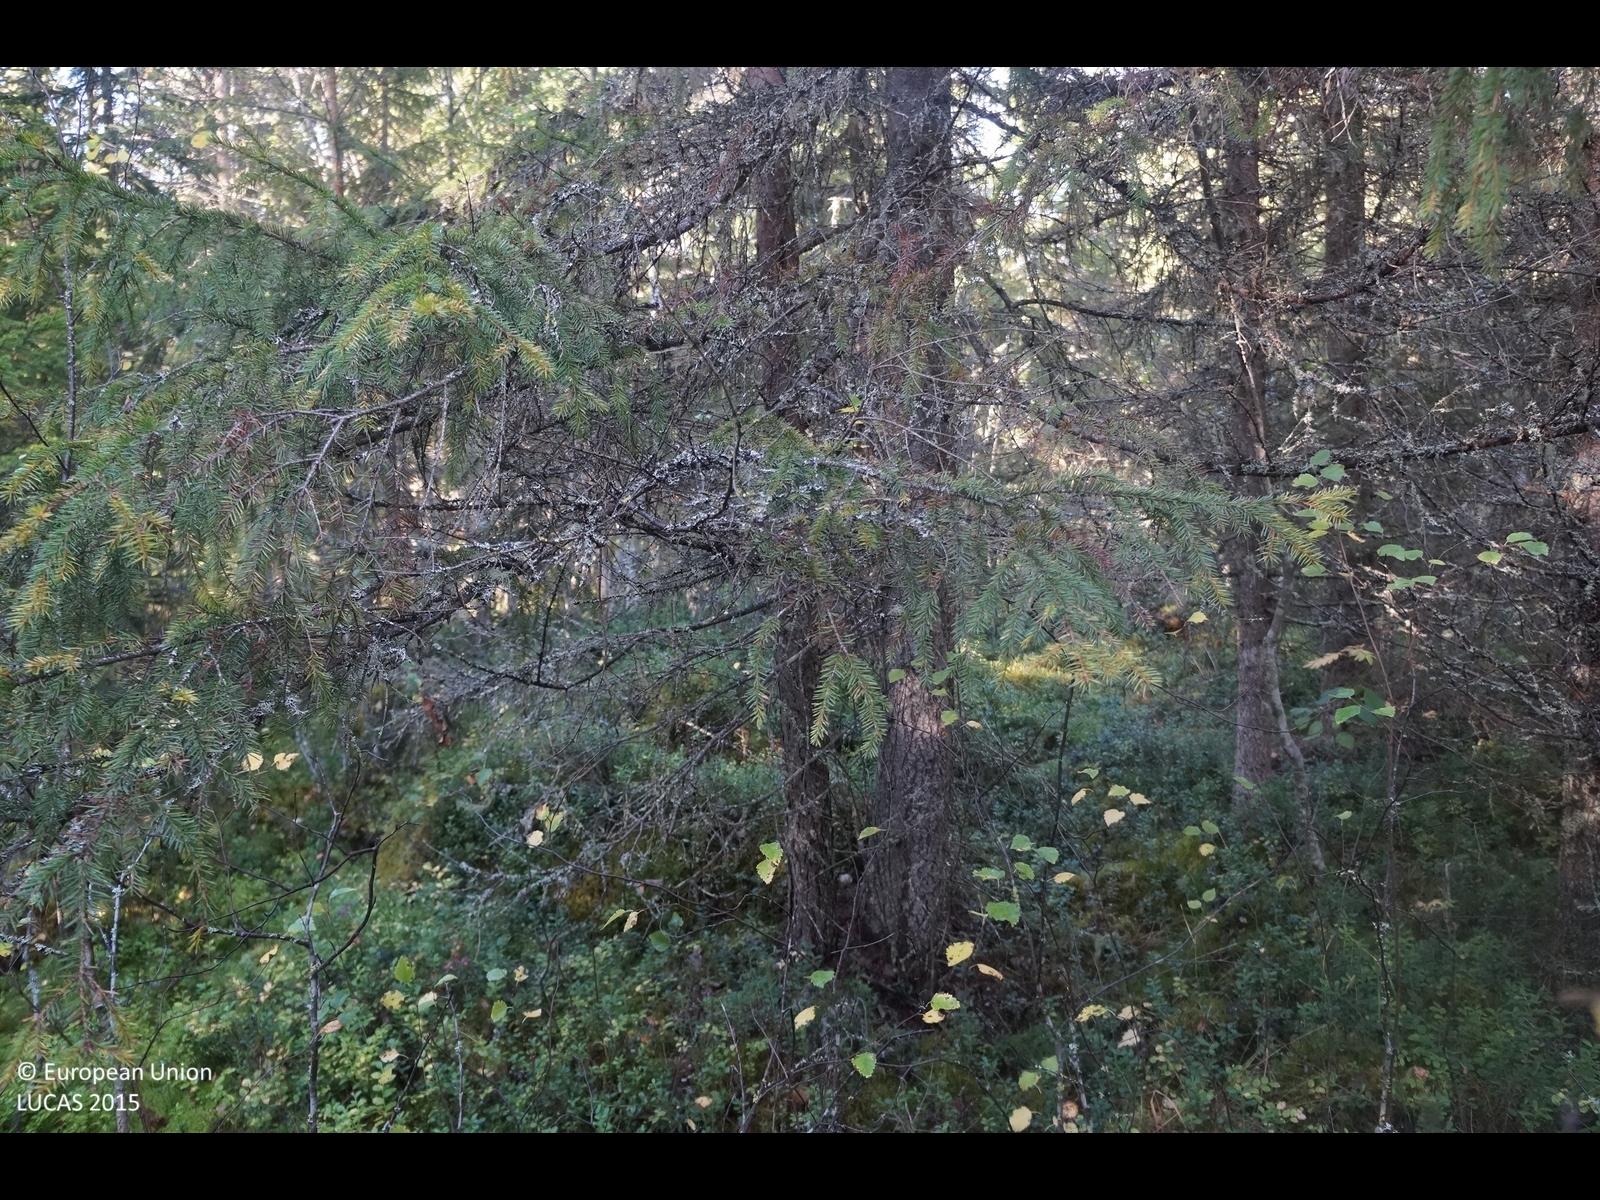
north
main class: Woodland
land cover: Spruce dominated mixed woodland
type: boreal forest
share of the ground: > 75 %
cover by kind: coniferous forest trees 55 %, broadleaved forest trees 20 %, lichens and mosses 15 %, shrubs 10 %
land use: Forestry
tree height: > 5 m
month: September
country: FI
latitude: 64.3369
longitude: 24.2846
